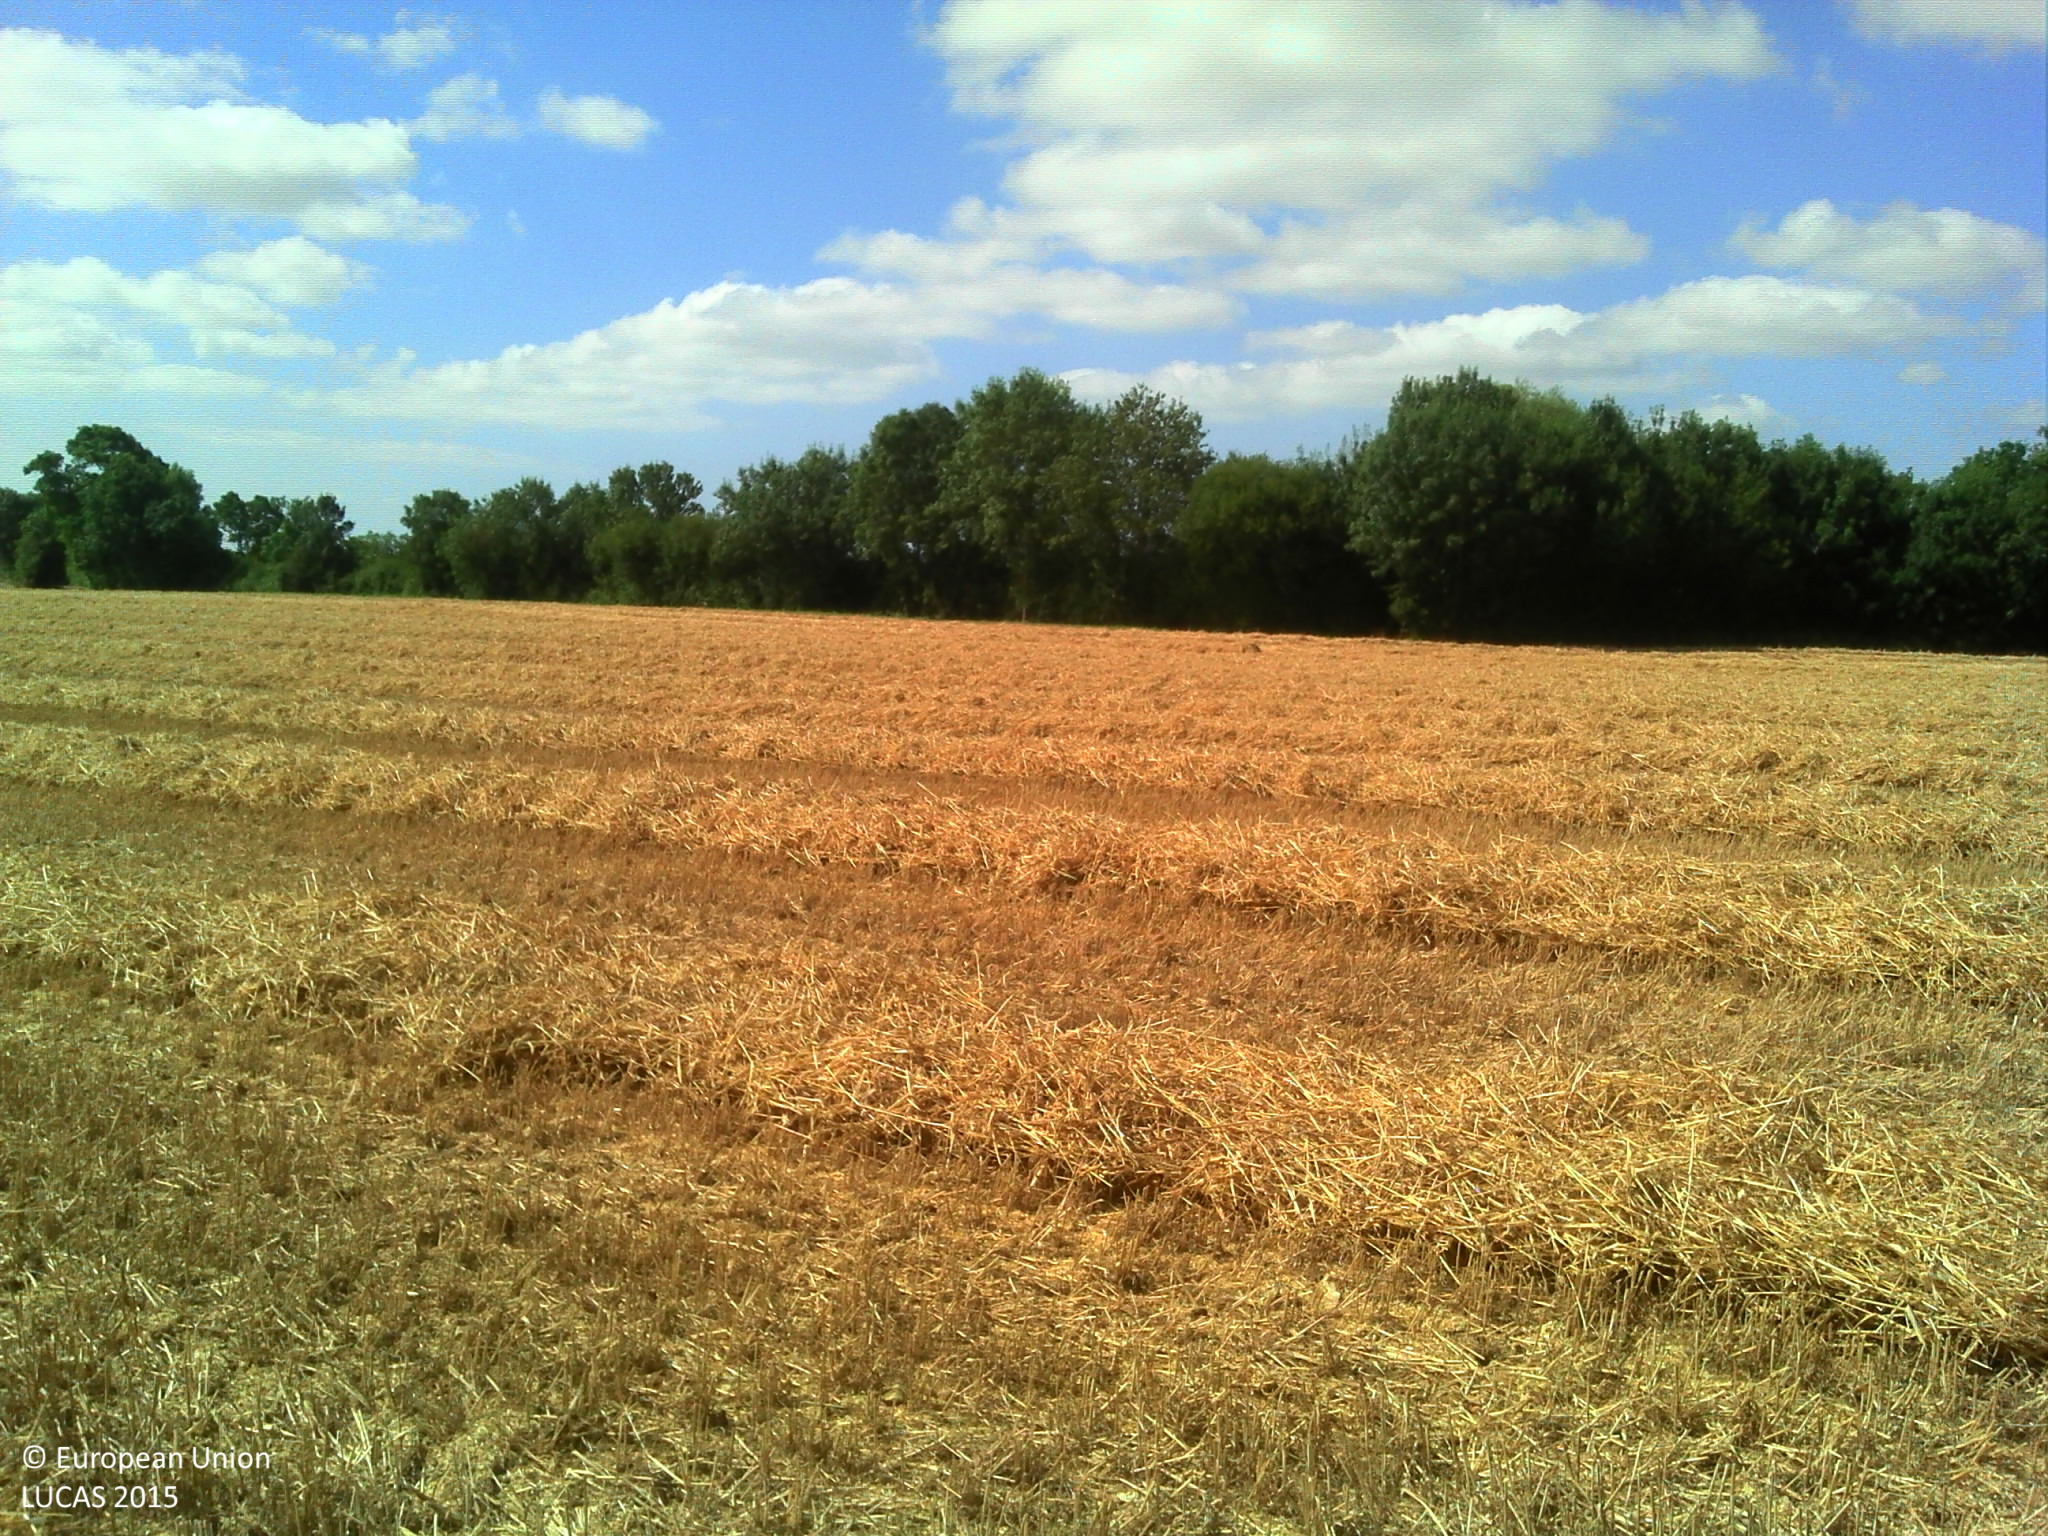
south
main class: Cropland
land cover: Common wheat
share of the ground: > 75 %
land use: Agriculture (excluding fallow land and kitchen gardens)
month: July
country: FR
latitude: 46.4158
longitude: -1.3676
